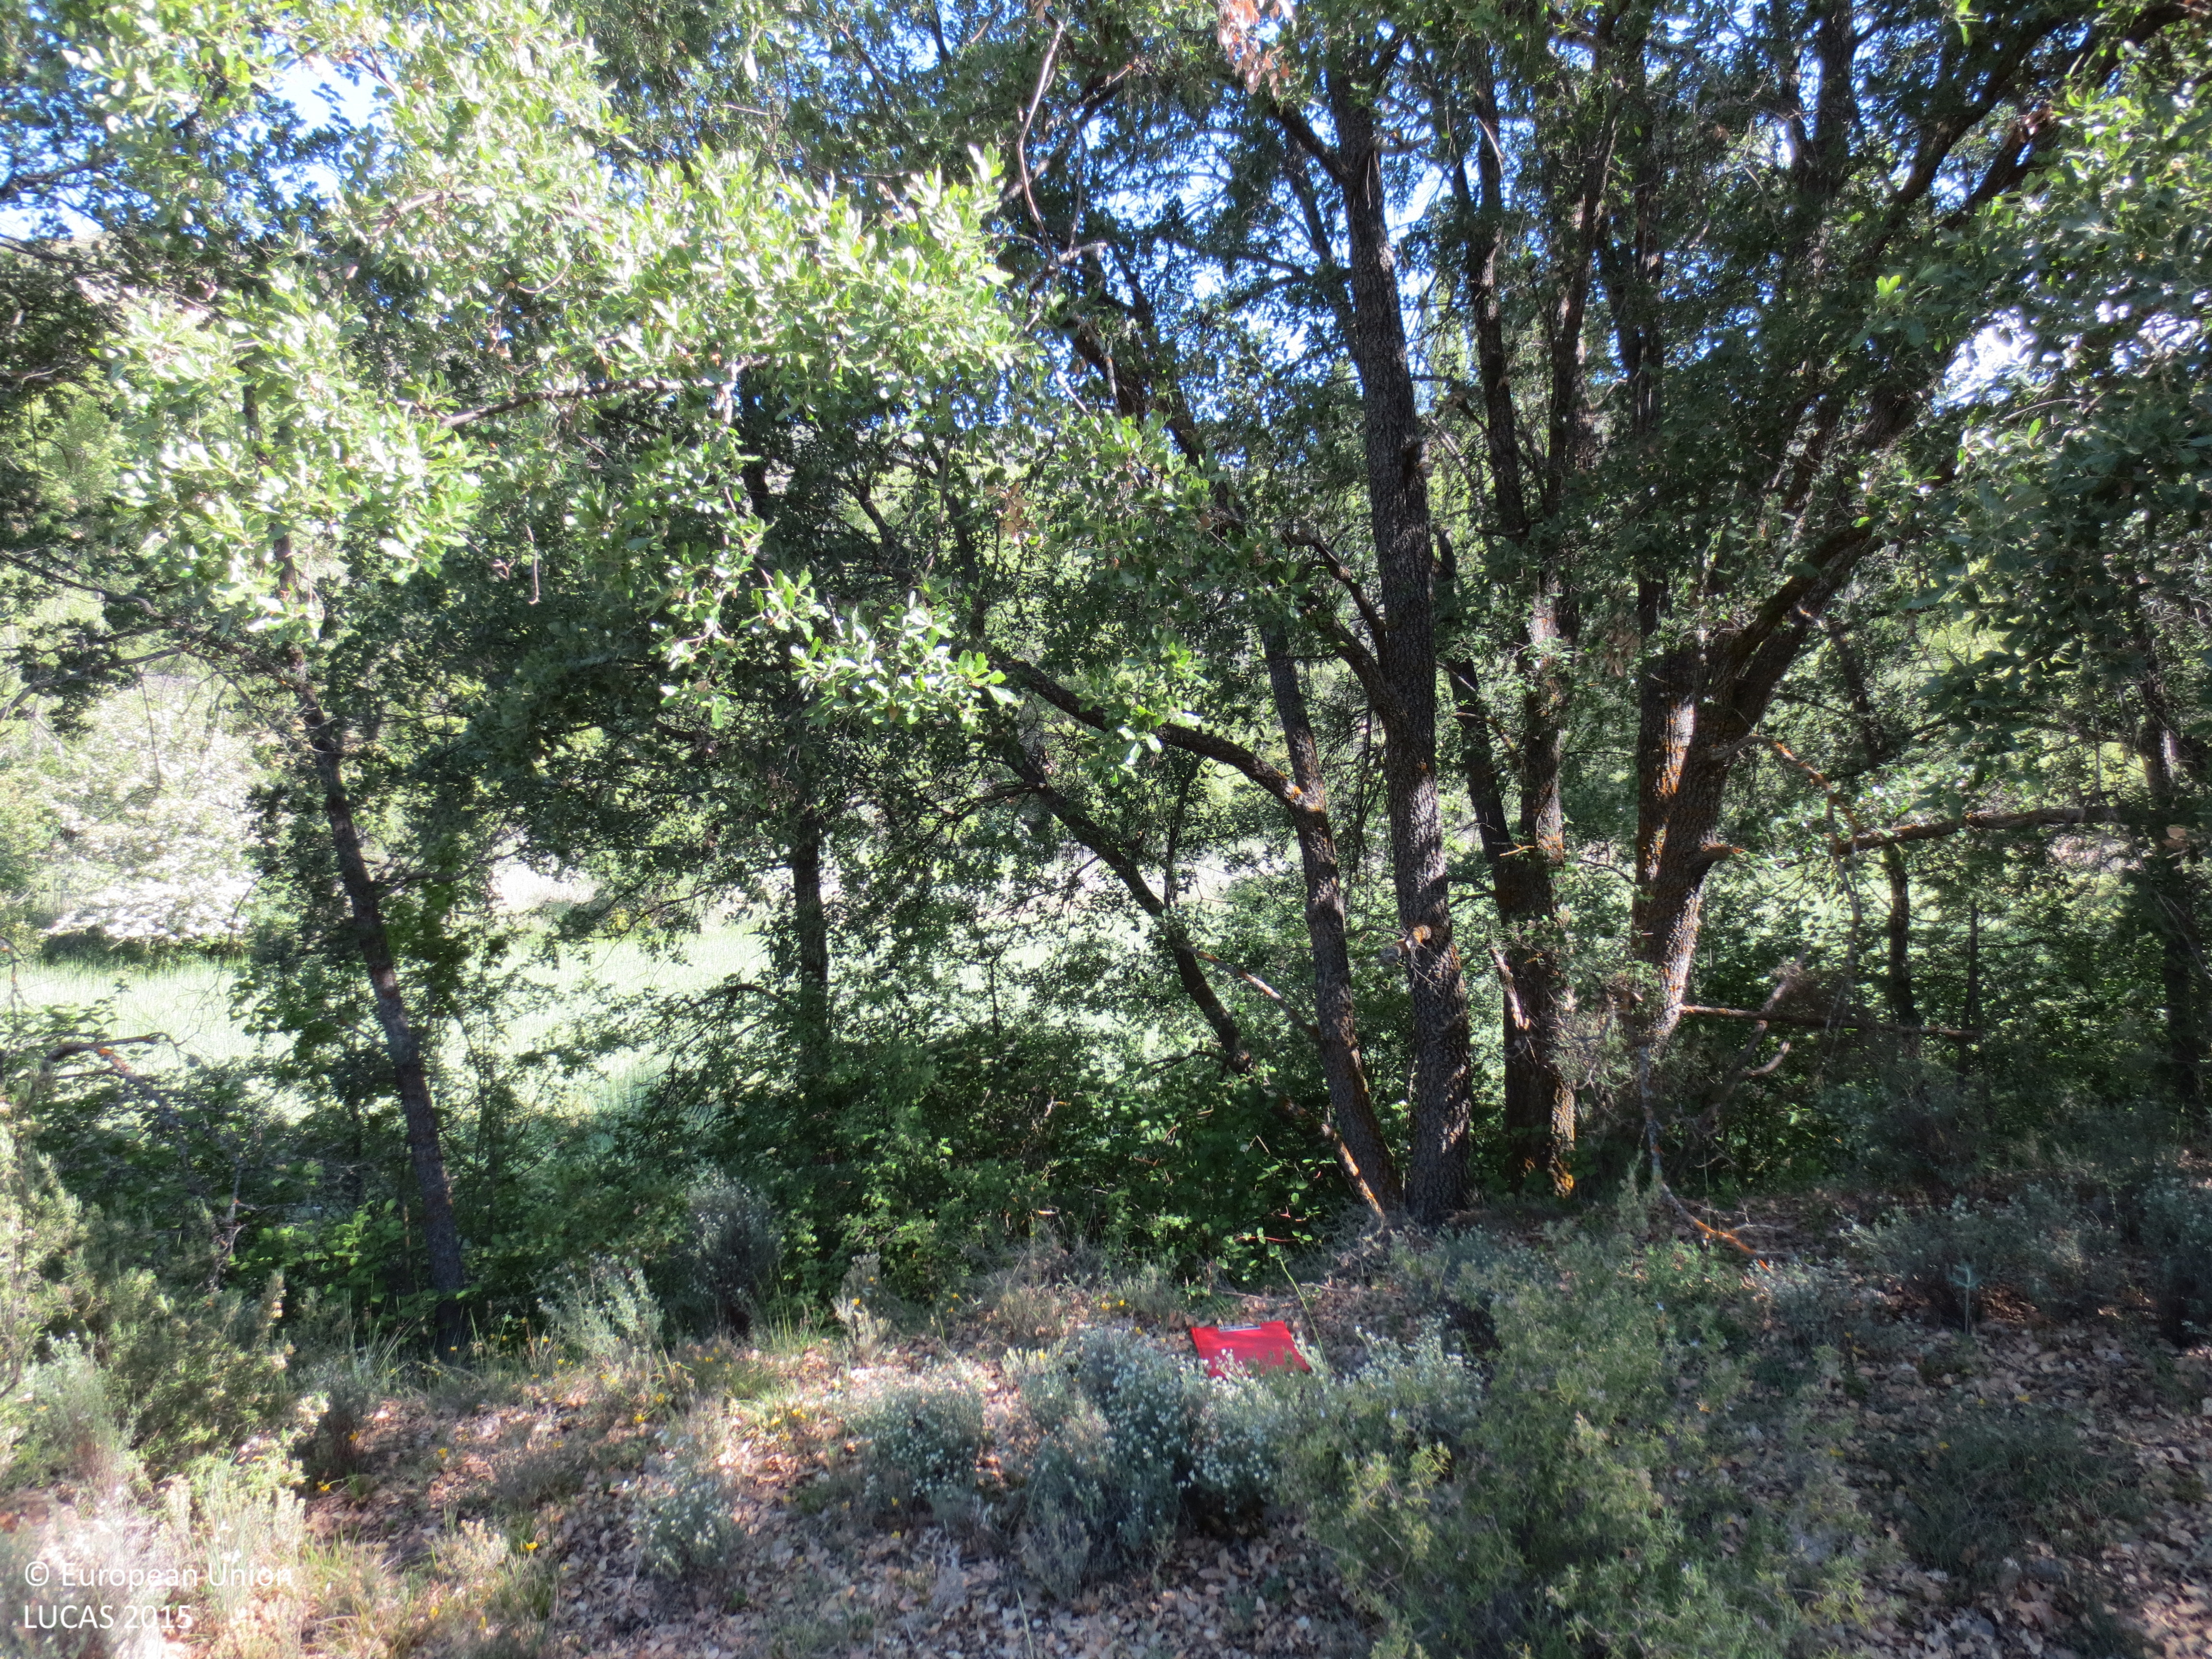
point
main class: Woodland
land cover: Broadleaved woodland
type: thermophilous deciduous forest
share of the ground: 25 - 50 %
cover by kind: broadleaved forest trees 45 %, shrubs 20 %, herbaceous plants 20 %, consolidated bare surface 10 %, coniferous forest trees 5 %
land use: Semi-natural and natural areas not in use
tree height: < 5 m
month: May
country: ES
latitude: 40.6434
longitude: -2.5731
